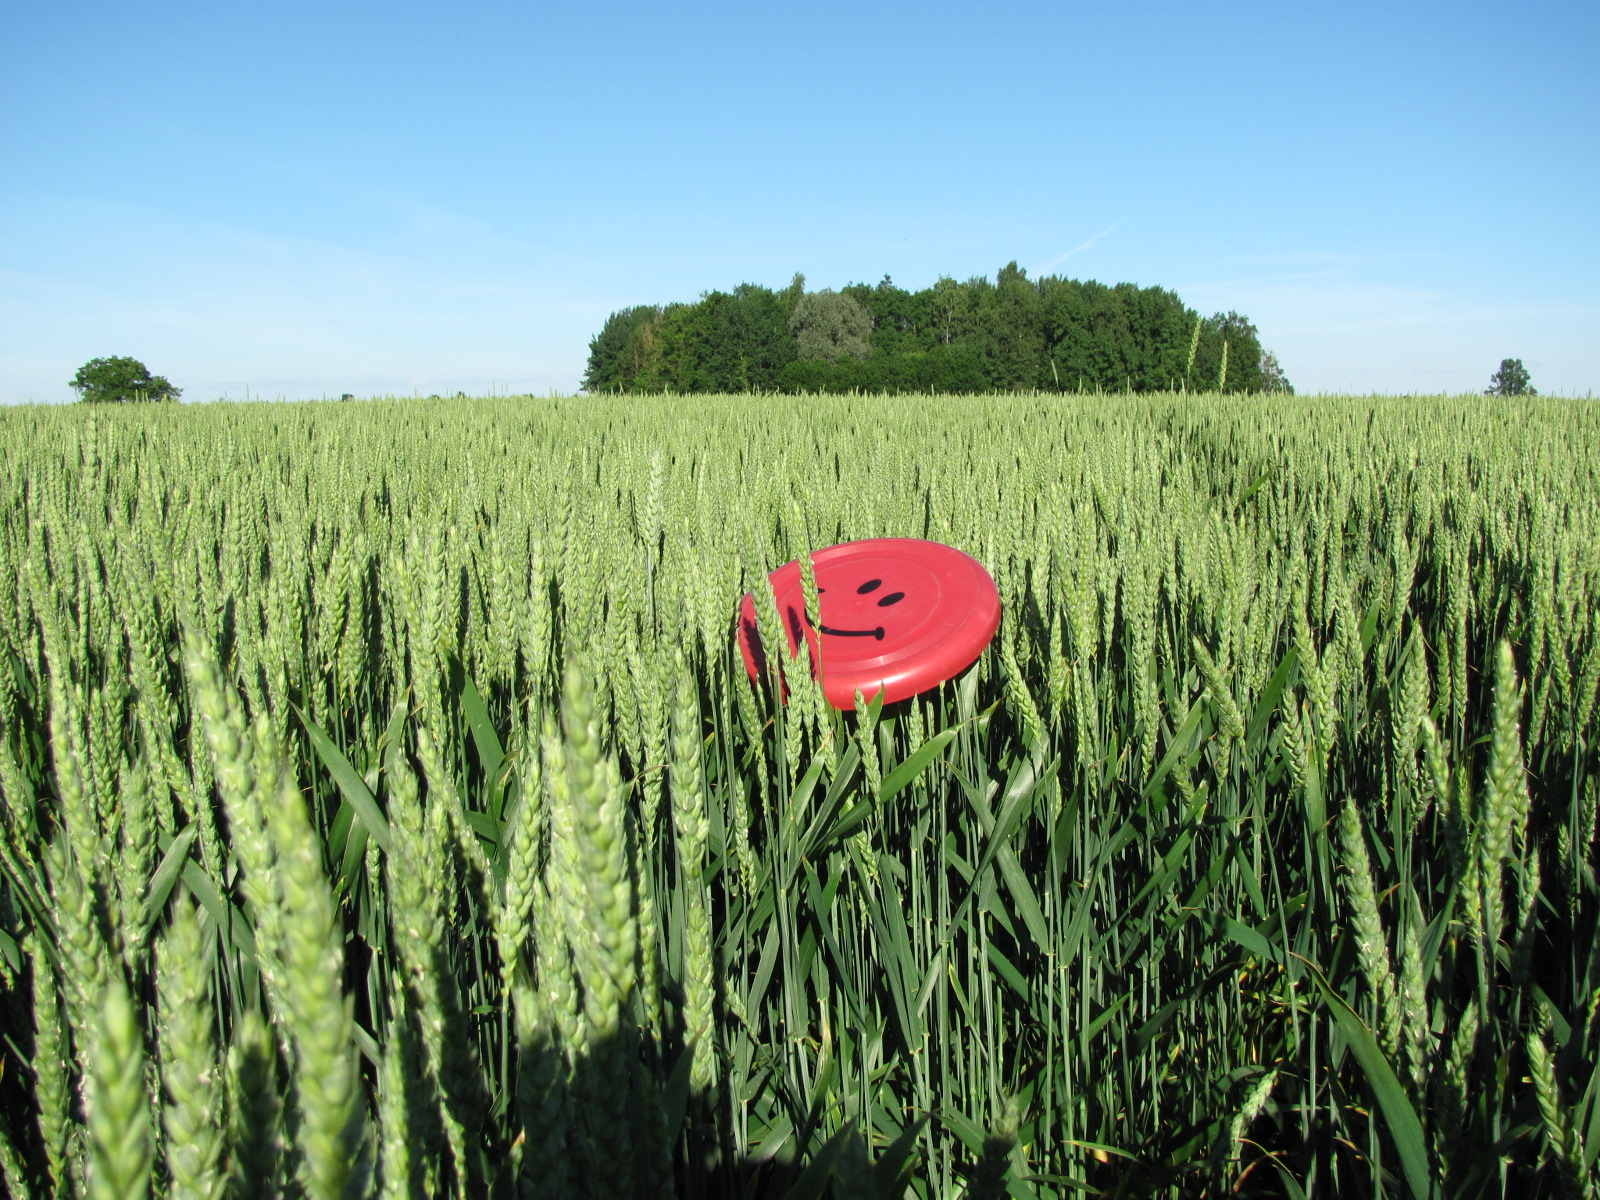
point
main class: Cropland
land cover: Common wheat
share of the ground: > 75 %
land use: Agriculture (excluding fallow land and kitchen gardens)
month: July
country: LV
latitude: 56.3840
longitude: 23.8325
